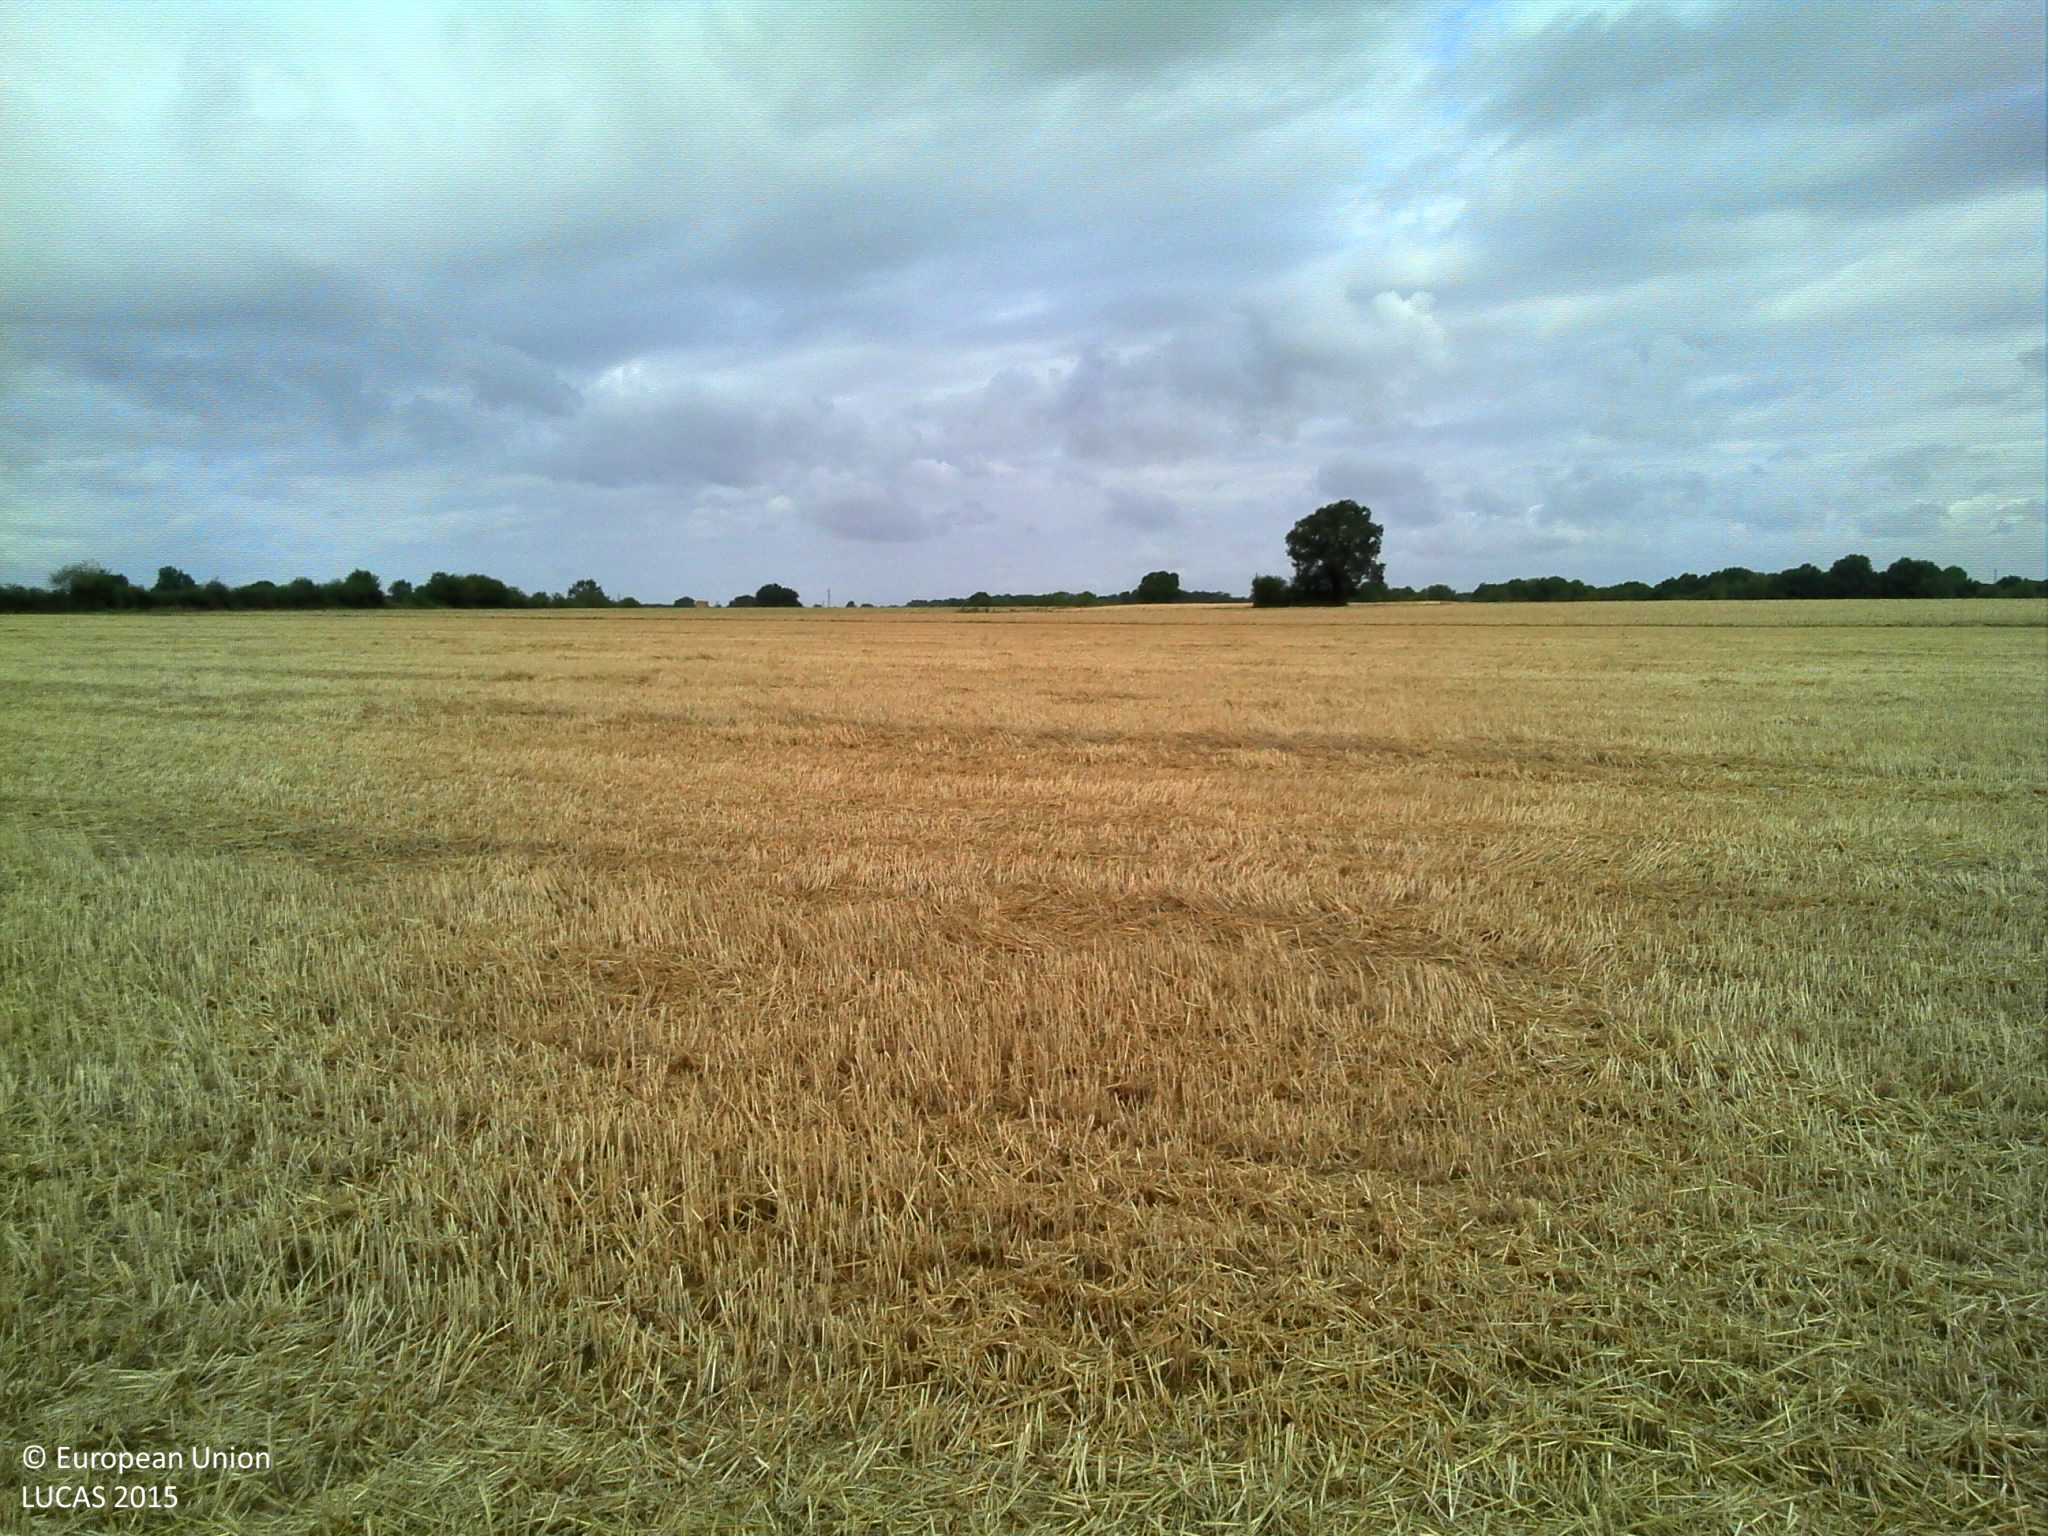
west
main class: Cropland
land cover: Common wheat
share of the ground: > 75 %
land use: Agriculture (excluding fallow land and kitchen gardens)
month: July
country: FR
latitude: 46.3471
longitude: 0.3273
